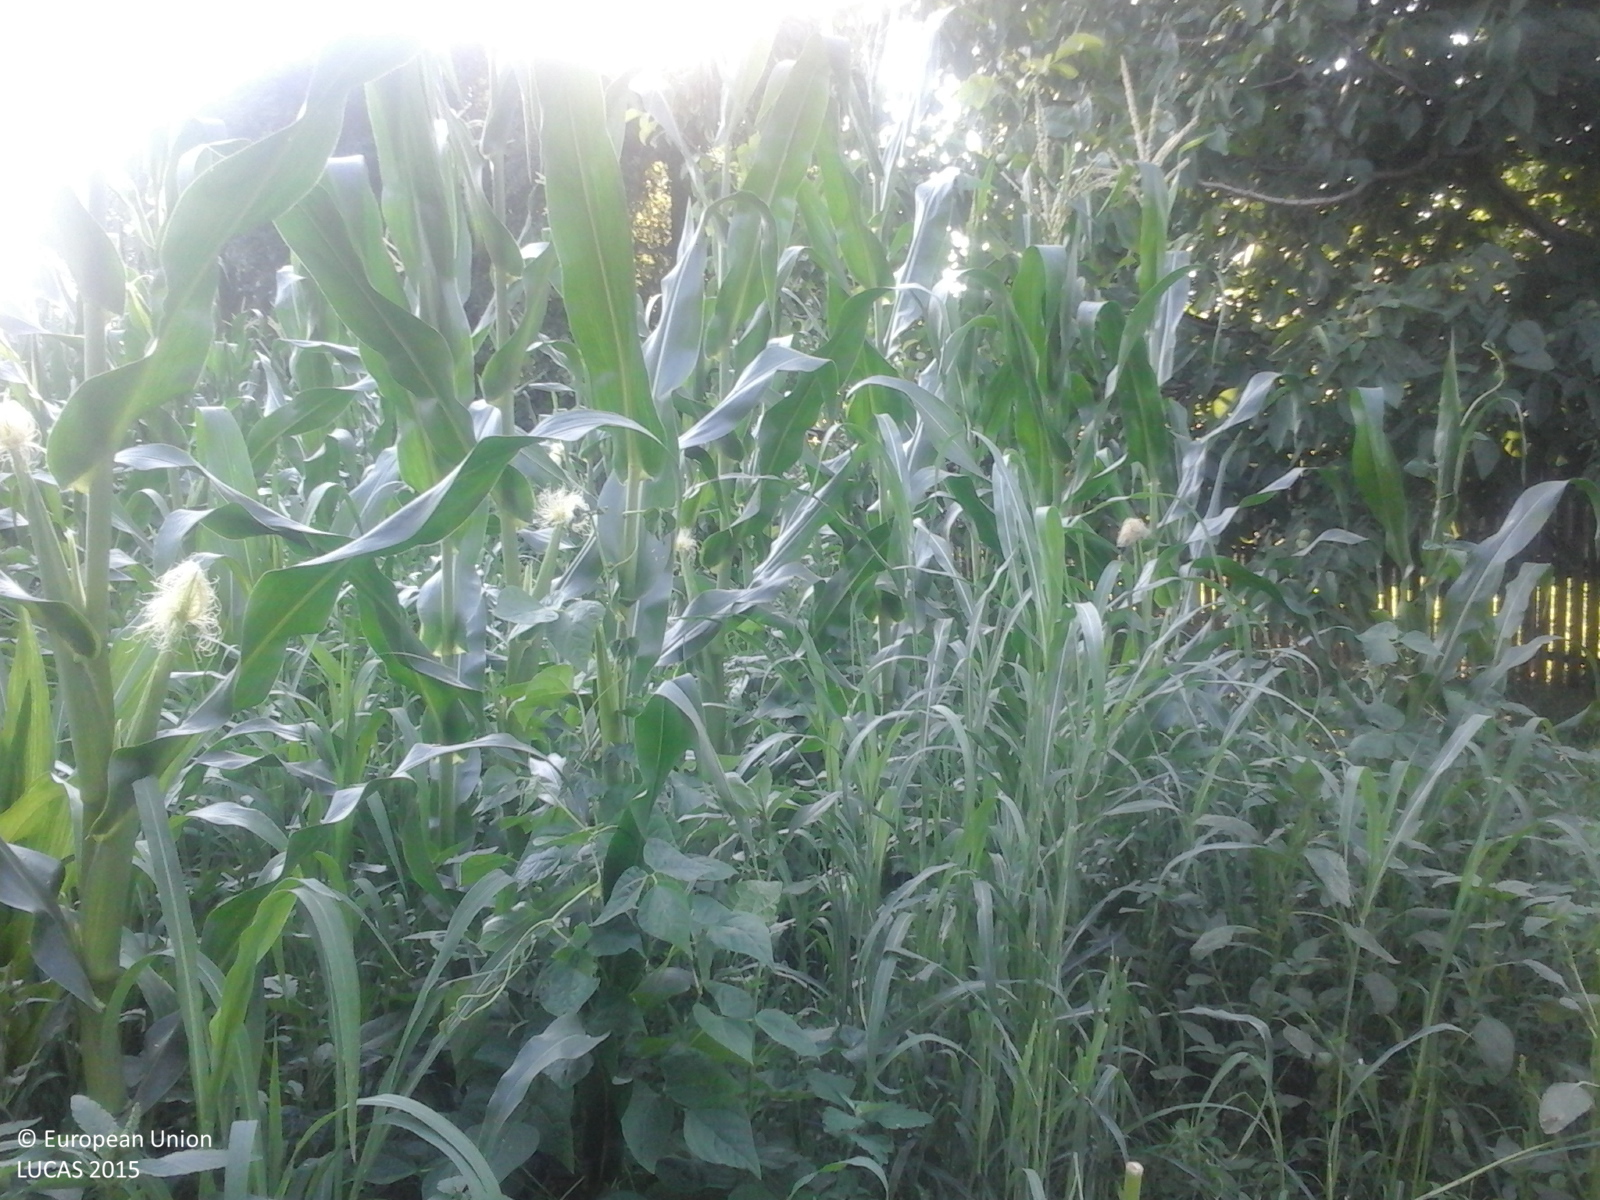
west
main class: Cropland
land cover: Maize
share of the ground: > 75 %
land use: Agriculture (excluding fallow land and kitchen gardens)
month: July
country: RO
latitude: 44.6073
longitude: 25.5028
